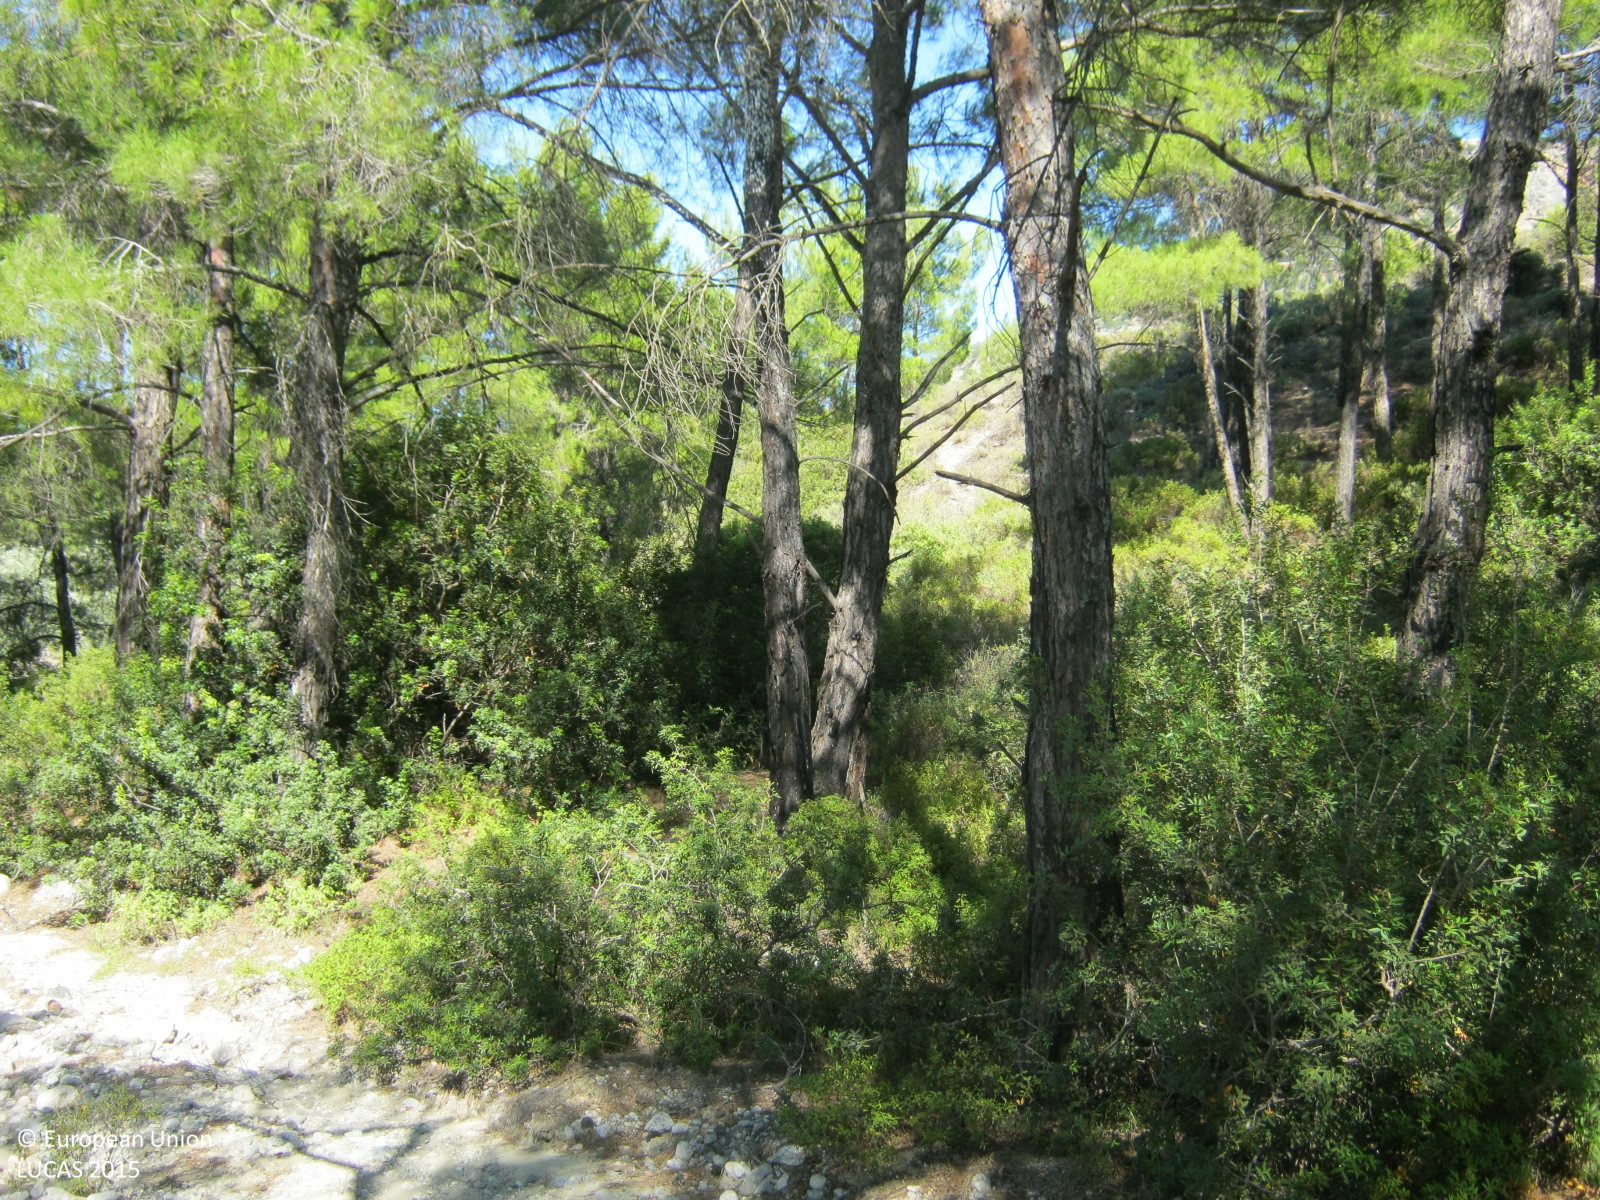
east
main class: Woodland
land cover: Pine dominated coniferous woodland
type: coniferous forest of the mediterranean region
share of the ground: > 75 %
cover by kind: coniferous forest trees 80 %, shrubs 15 %, herbaceous plants 5 %
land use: Semi-natural and natural areas not in use
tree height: > 5 m
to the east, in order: Pine dominated coniferous woodland
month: June
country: GR
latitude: 36.1919
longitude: 28.0411
